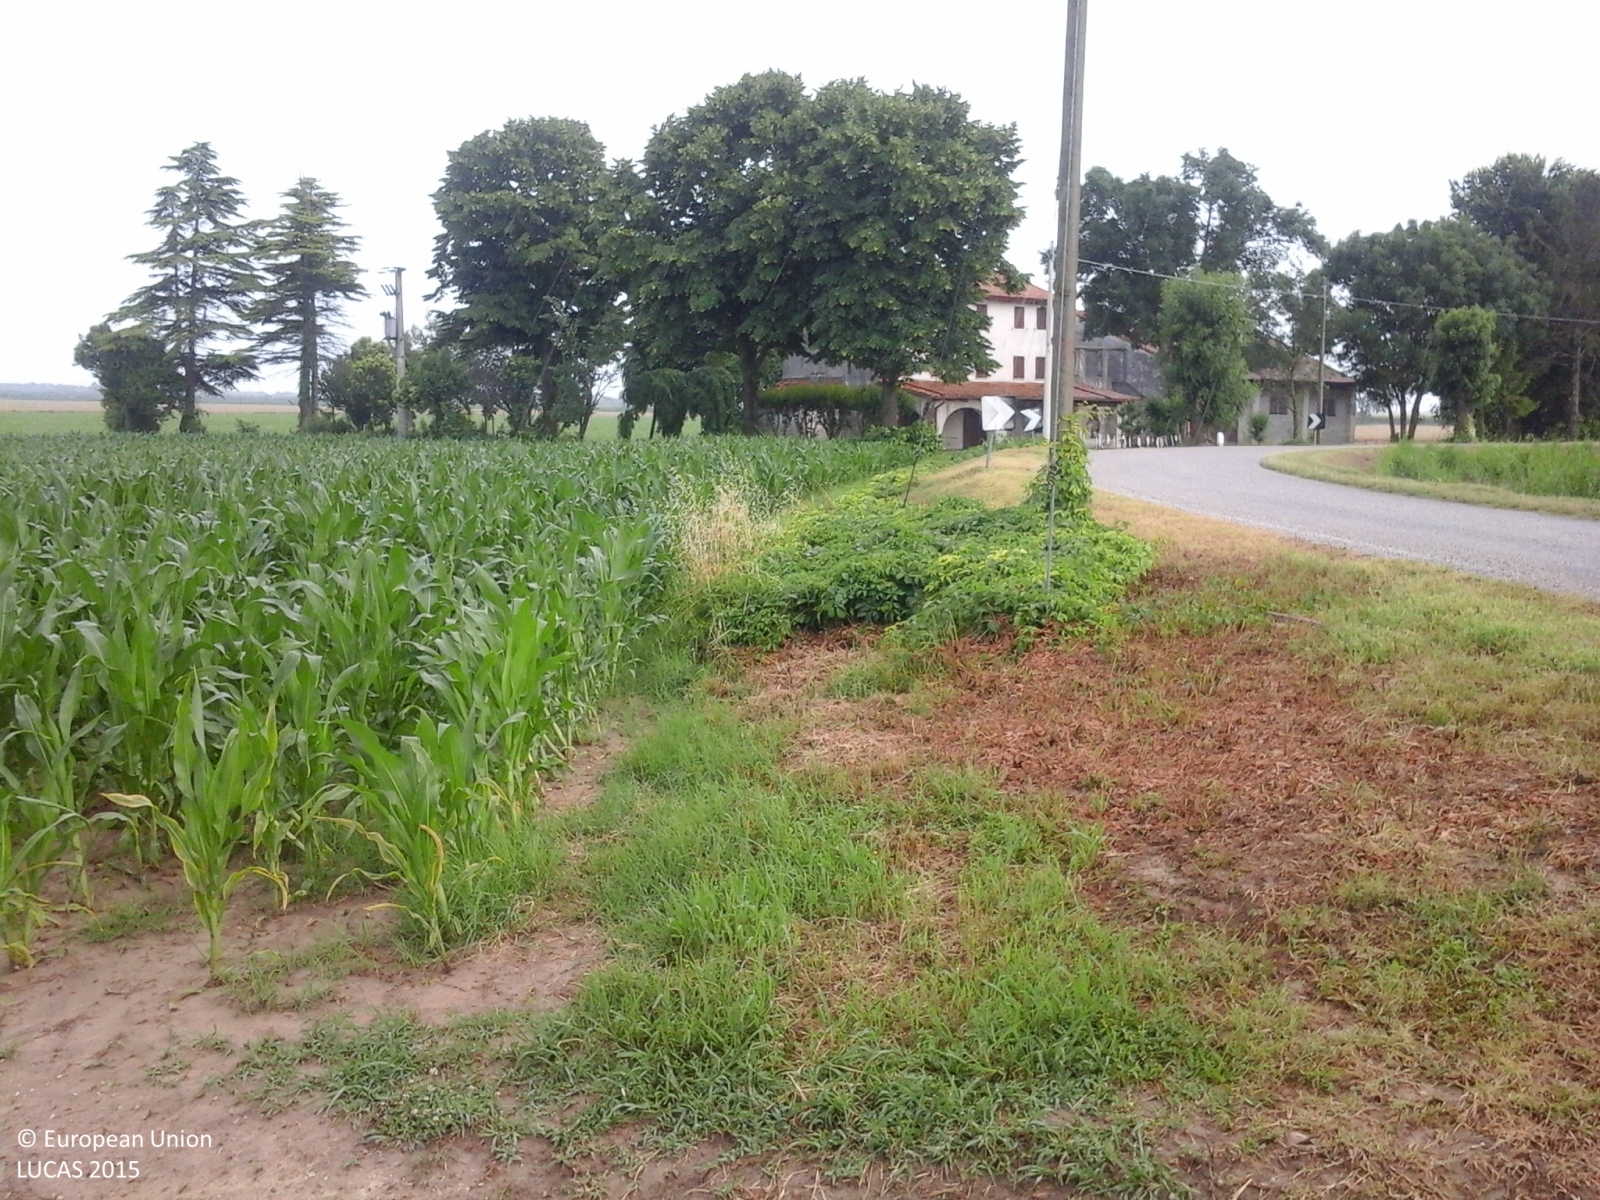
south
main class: Cropland
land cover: Maize
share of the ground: > 75 %
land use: Agriculture (excluding fallow land and kitchen gardens)
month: June
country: IT
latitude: 45.6308
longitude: 12.7540
